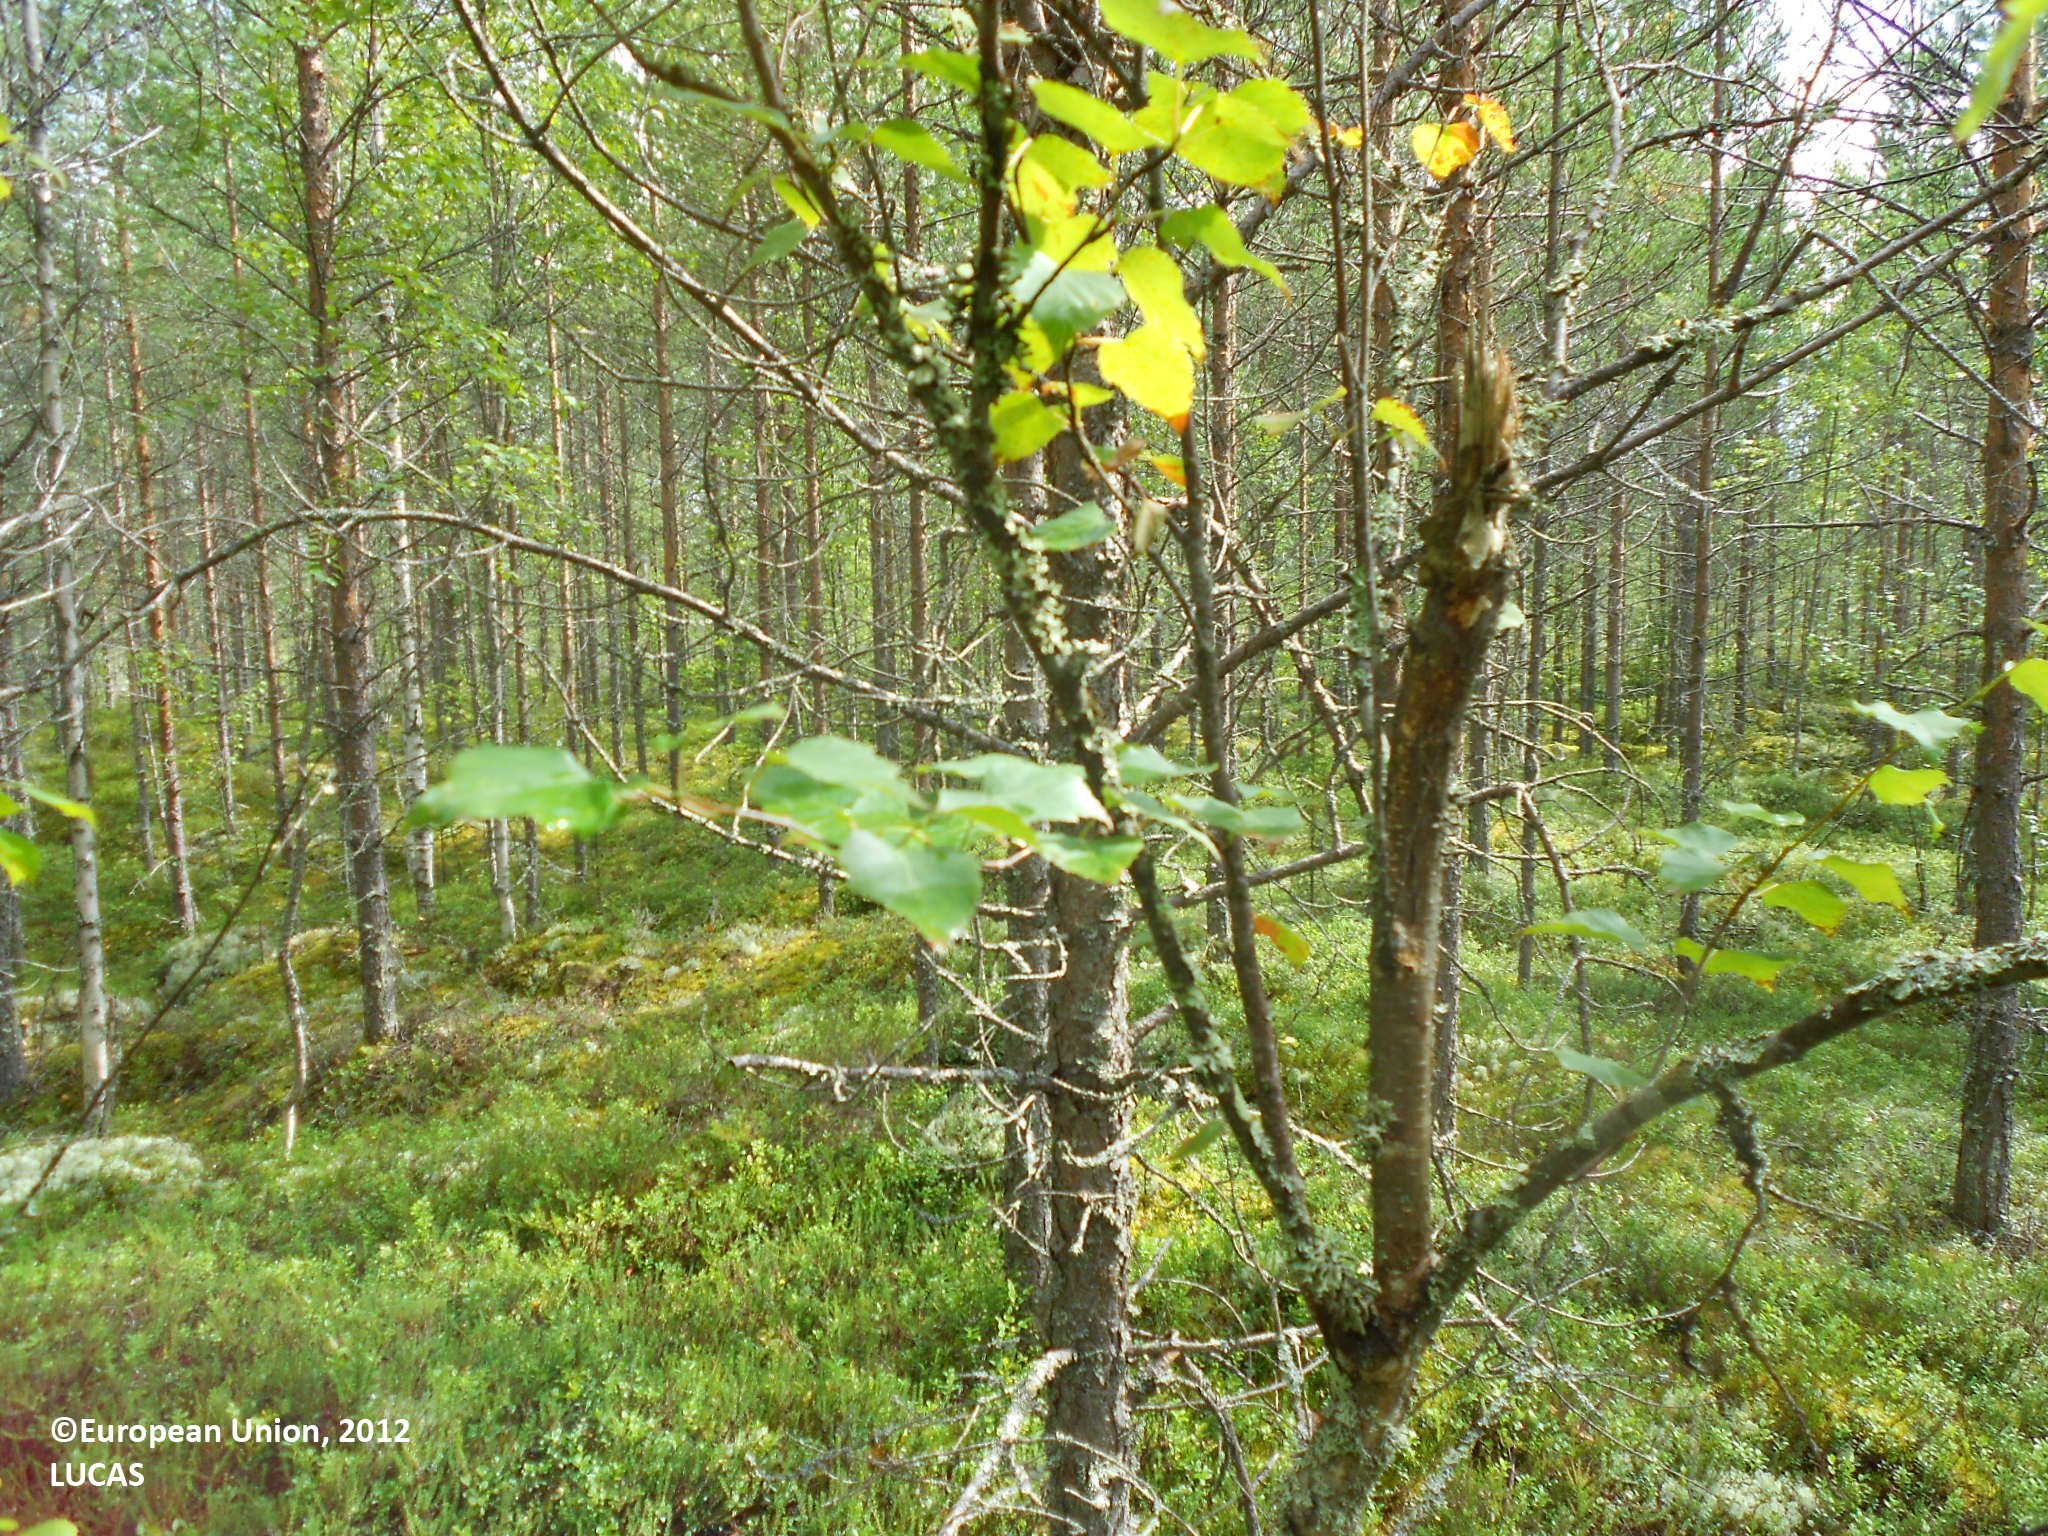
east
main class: Woodland
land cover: Pine dominated coniferous woodland
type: boreal forest
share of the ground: 50 - 75 %
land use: Forestry
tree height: > 5 m
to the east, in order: Pine dominated coniferous woodland; Tracks; Pine dominated coniferous woodland
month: August
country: FI
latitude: 63.3529
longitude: 28.4767
